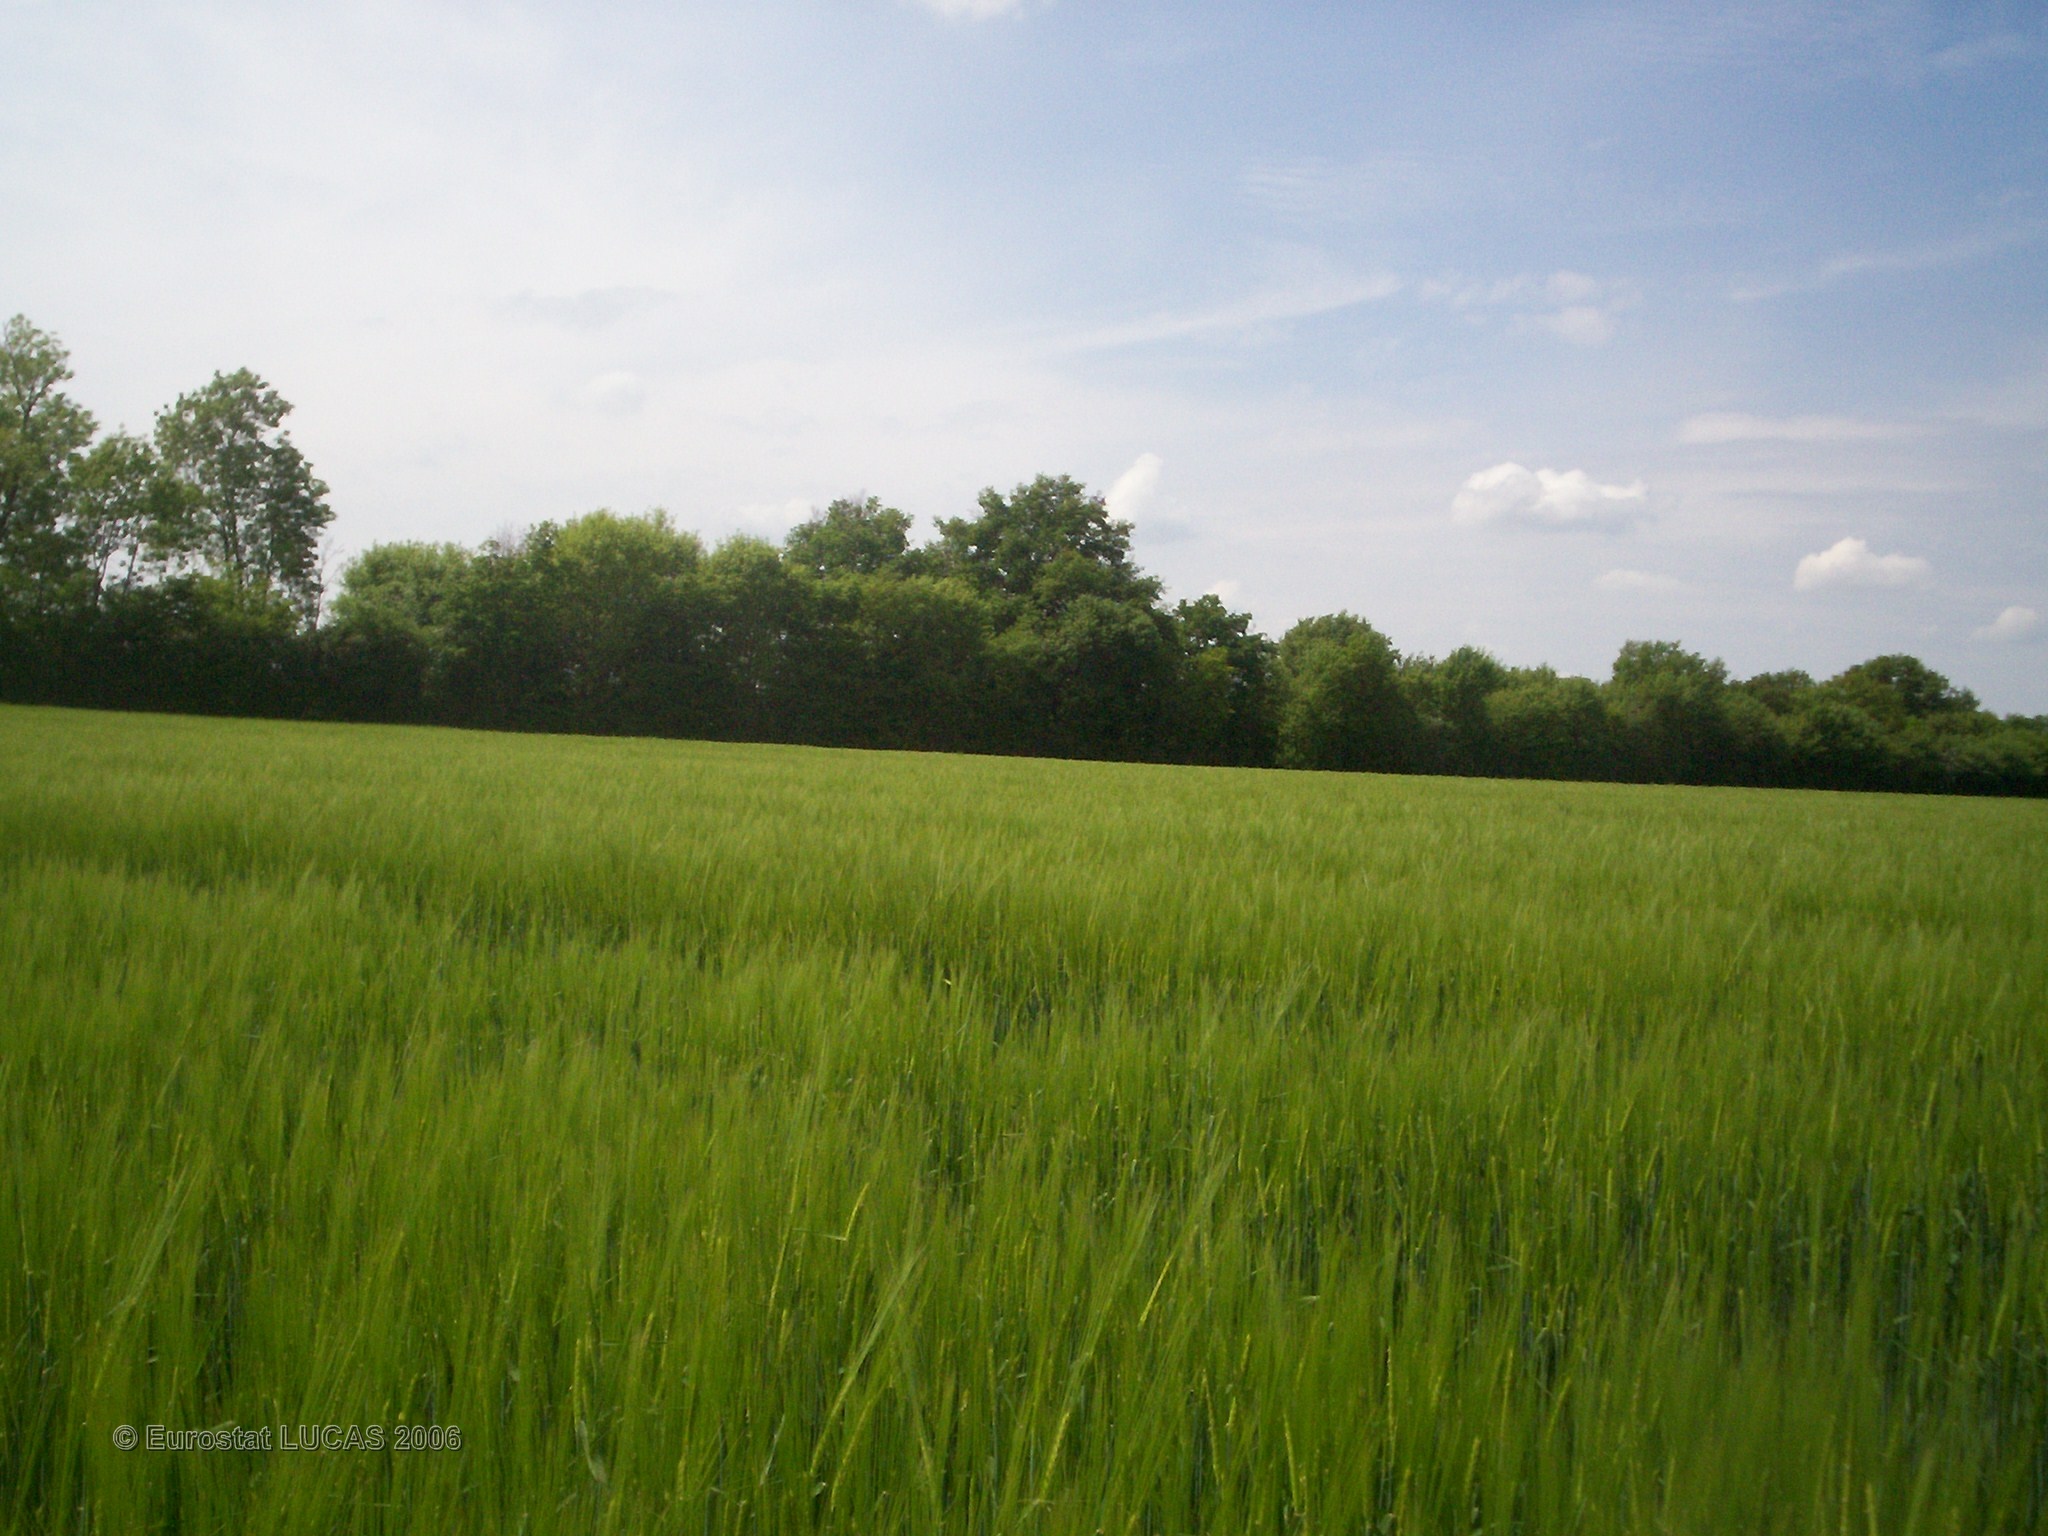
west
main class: Cropland
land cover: Barley
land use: Agriculture (excluding fallow land and kitchen gardens)
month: May
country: FR
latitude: 47.6759
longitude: 3.0010
